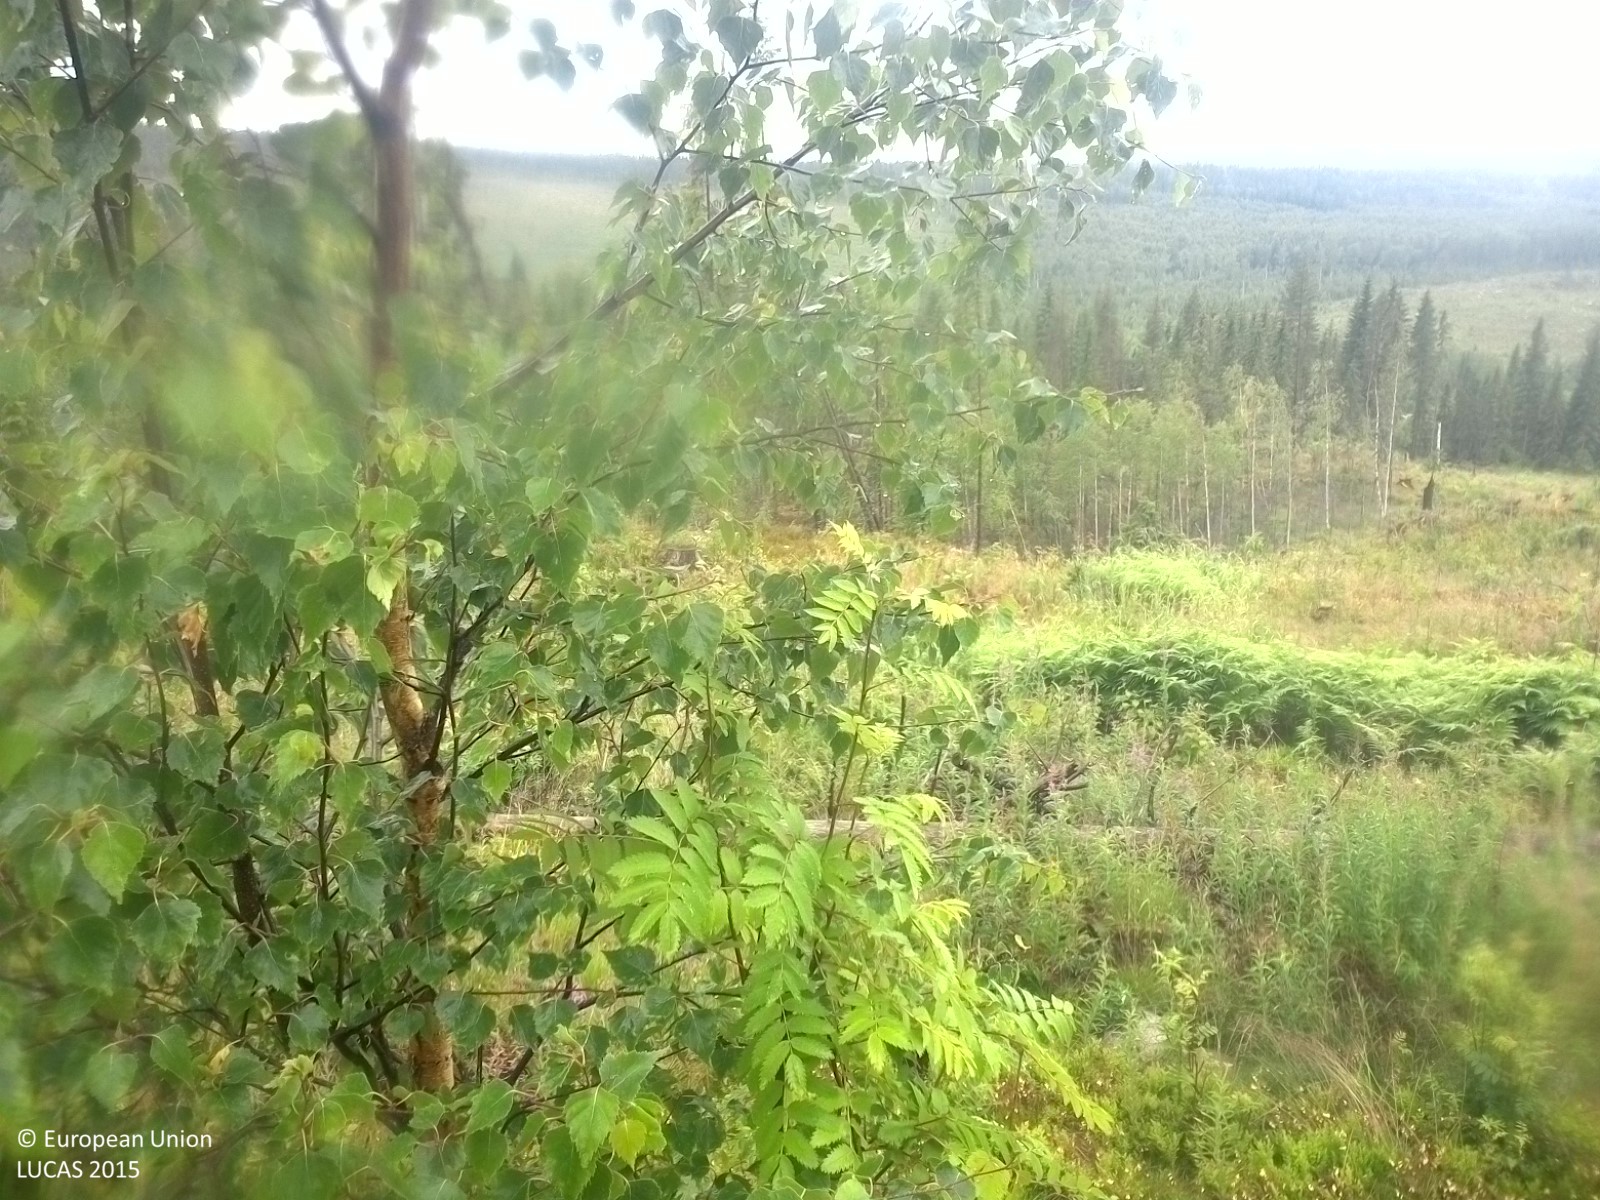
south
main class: Woodland
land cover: Other mixed woodland
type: boreal forest
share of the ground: 25 - 50 %
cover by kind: broadleaved forest trees 25 %, herbaceous plants 25 %, shrubs 20 %, lichens and mosses 20 %, coniferous forest trees 10 %
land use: Forestry
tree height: < 5 m
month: July
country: SE
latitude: 62.4112
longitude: 17.0446
